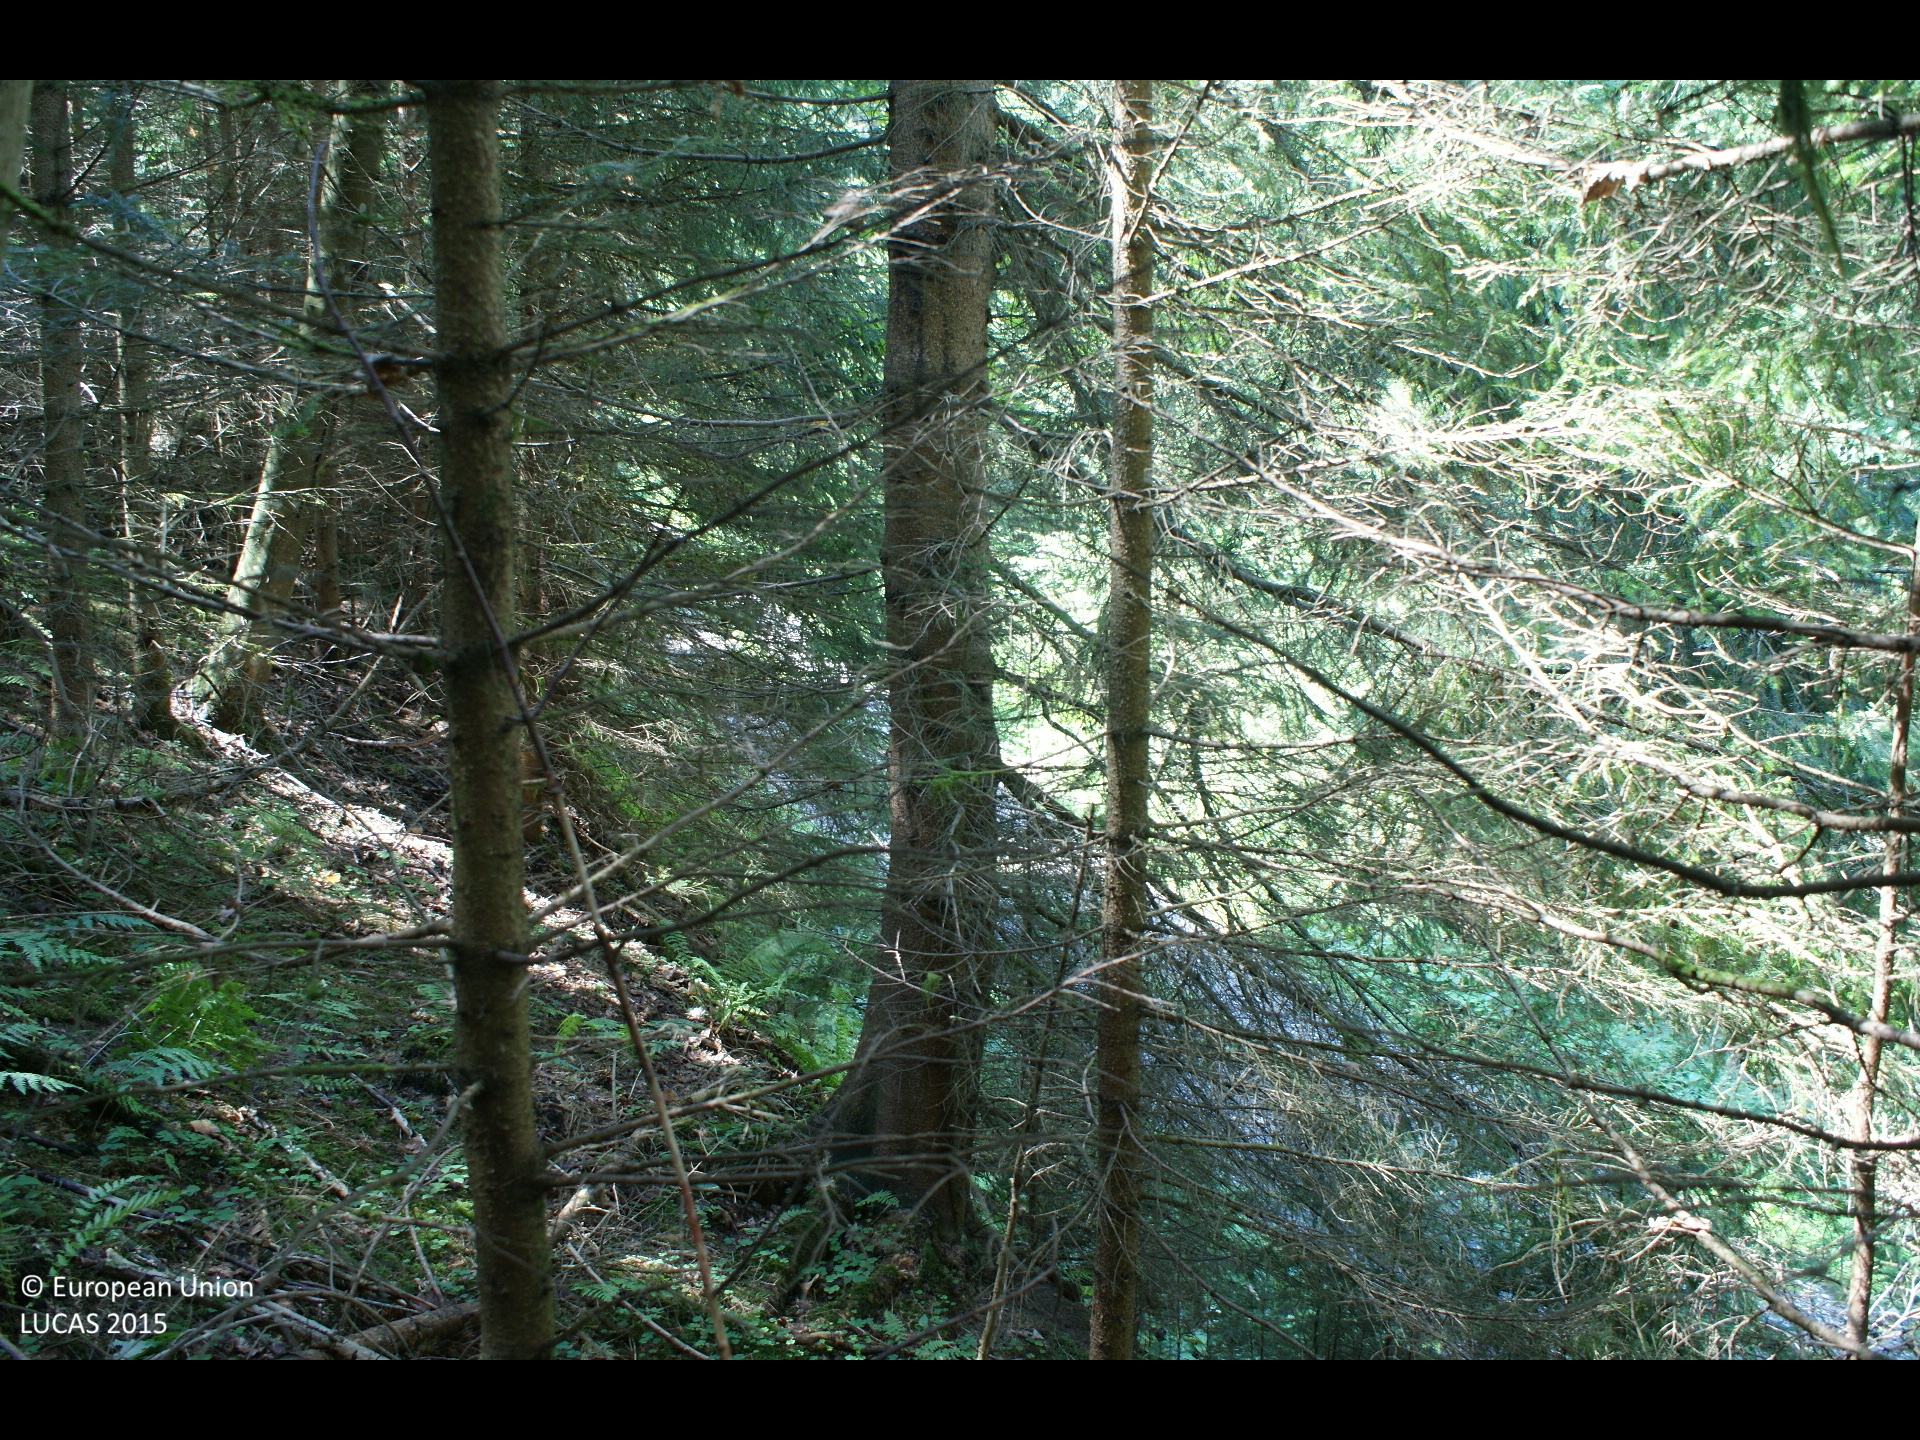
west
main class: Woodland
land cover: Spruce dominated mixed woodland
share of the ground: > 75 %
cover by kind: coniferous forest trees 65 %, broadleaved forest trees 25 %, herbaceous plants 5 %, lichens and mosses 5 %
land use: Forestry
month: July
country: AT
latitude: 47.7937
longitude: 14.8194
